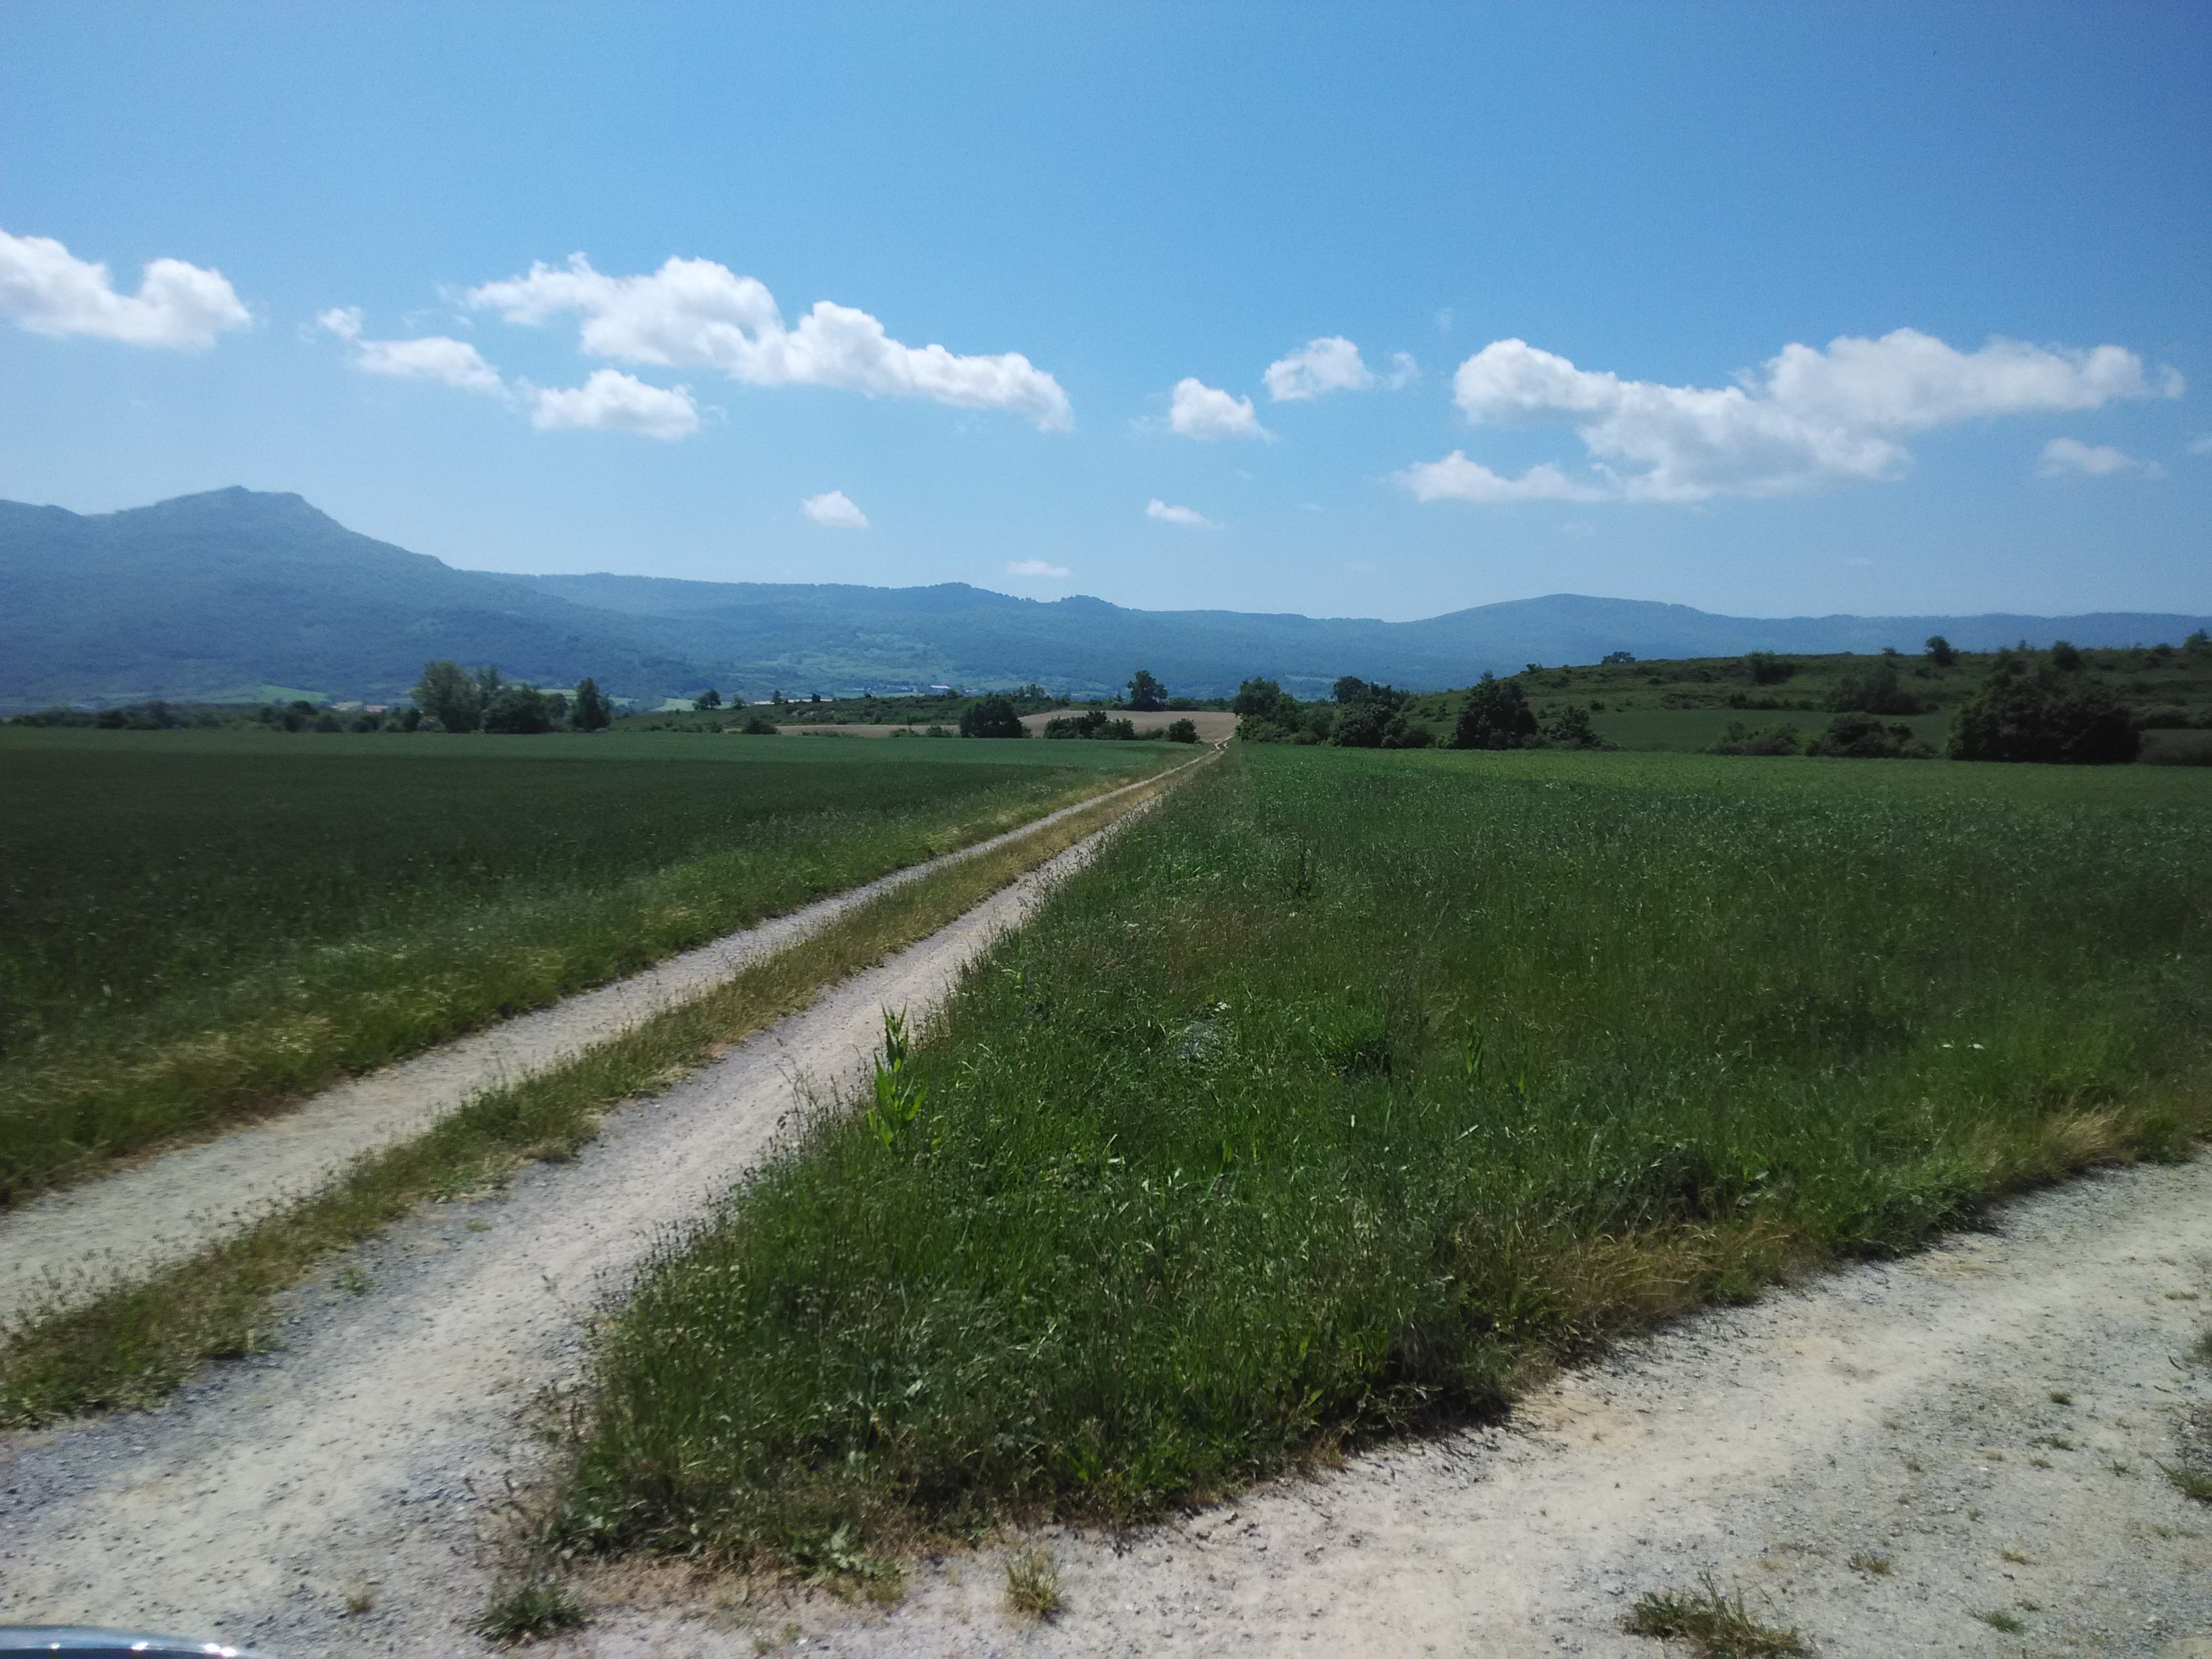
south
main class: Cropland
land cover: Barley
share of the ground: > 75 %
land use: Agriculture (excluding fallow land and kitchen gardens)
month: June
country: ES
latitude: 42.8801
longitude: -2.3518
